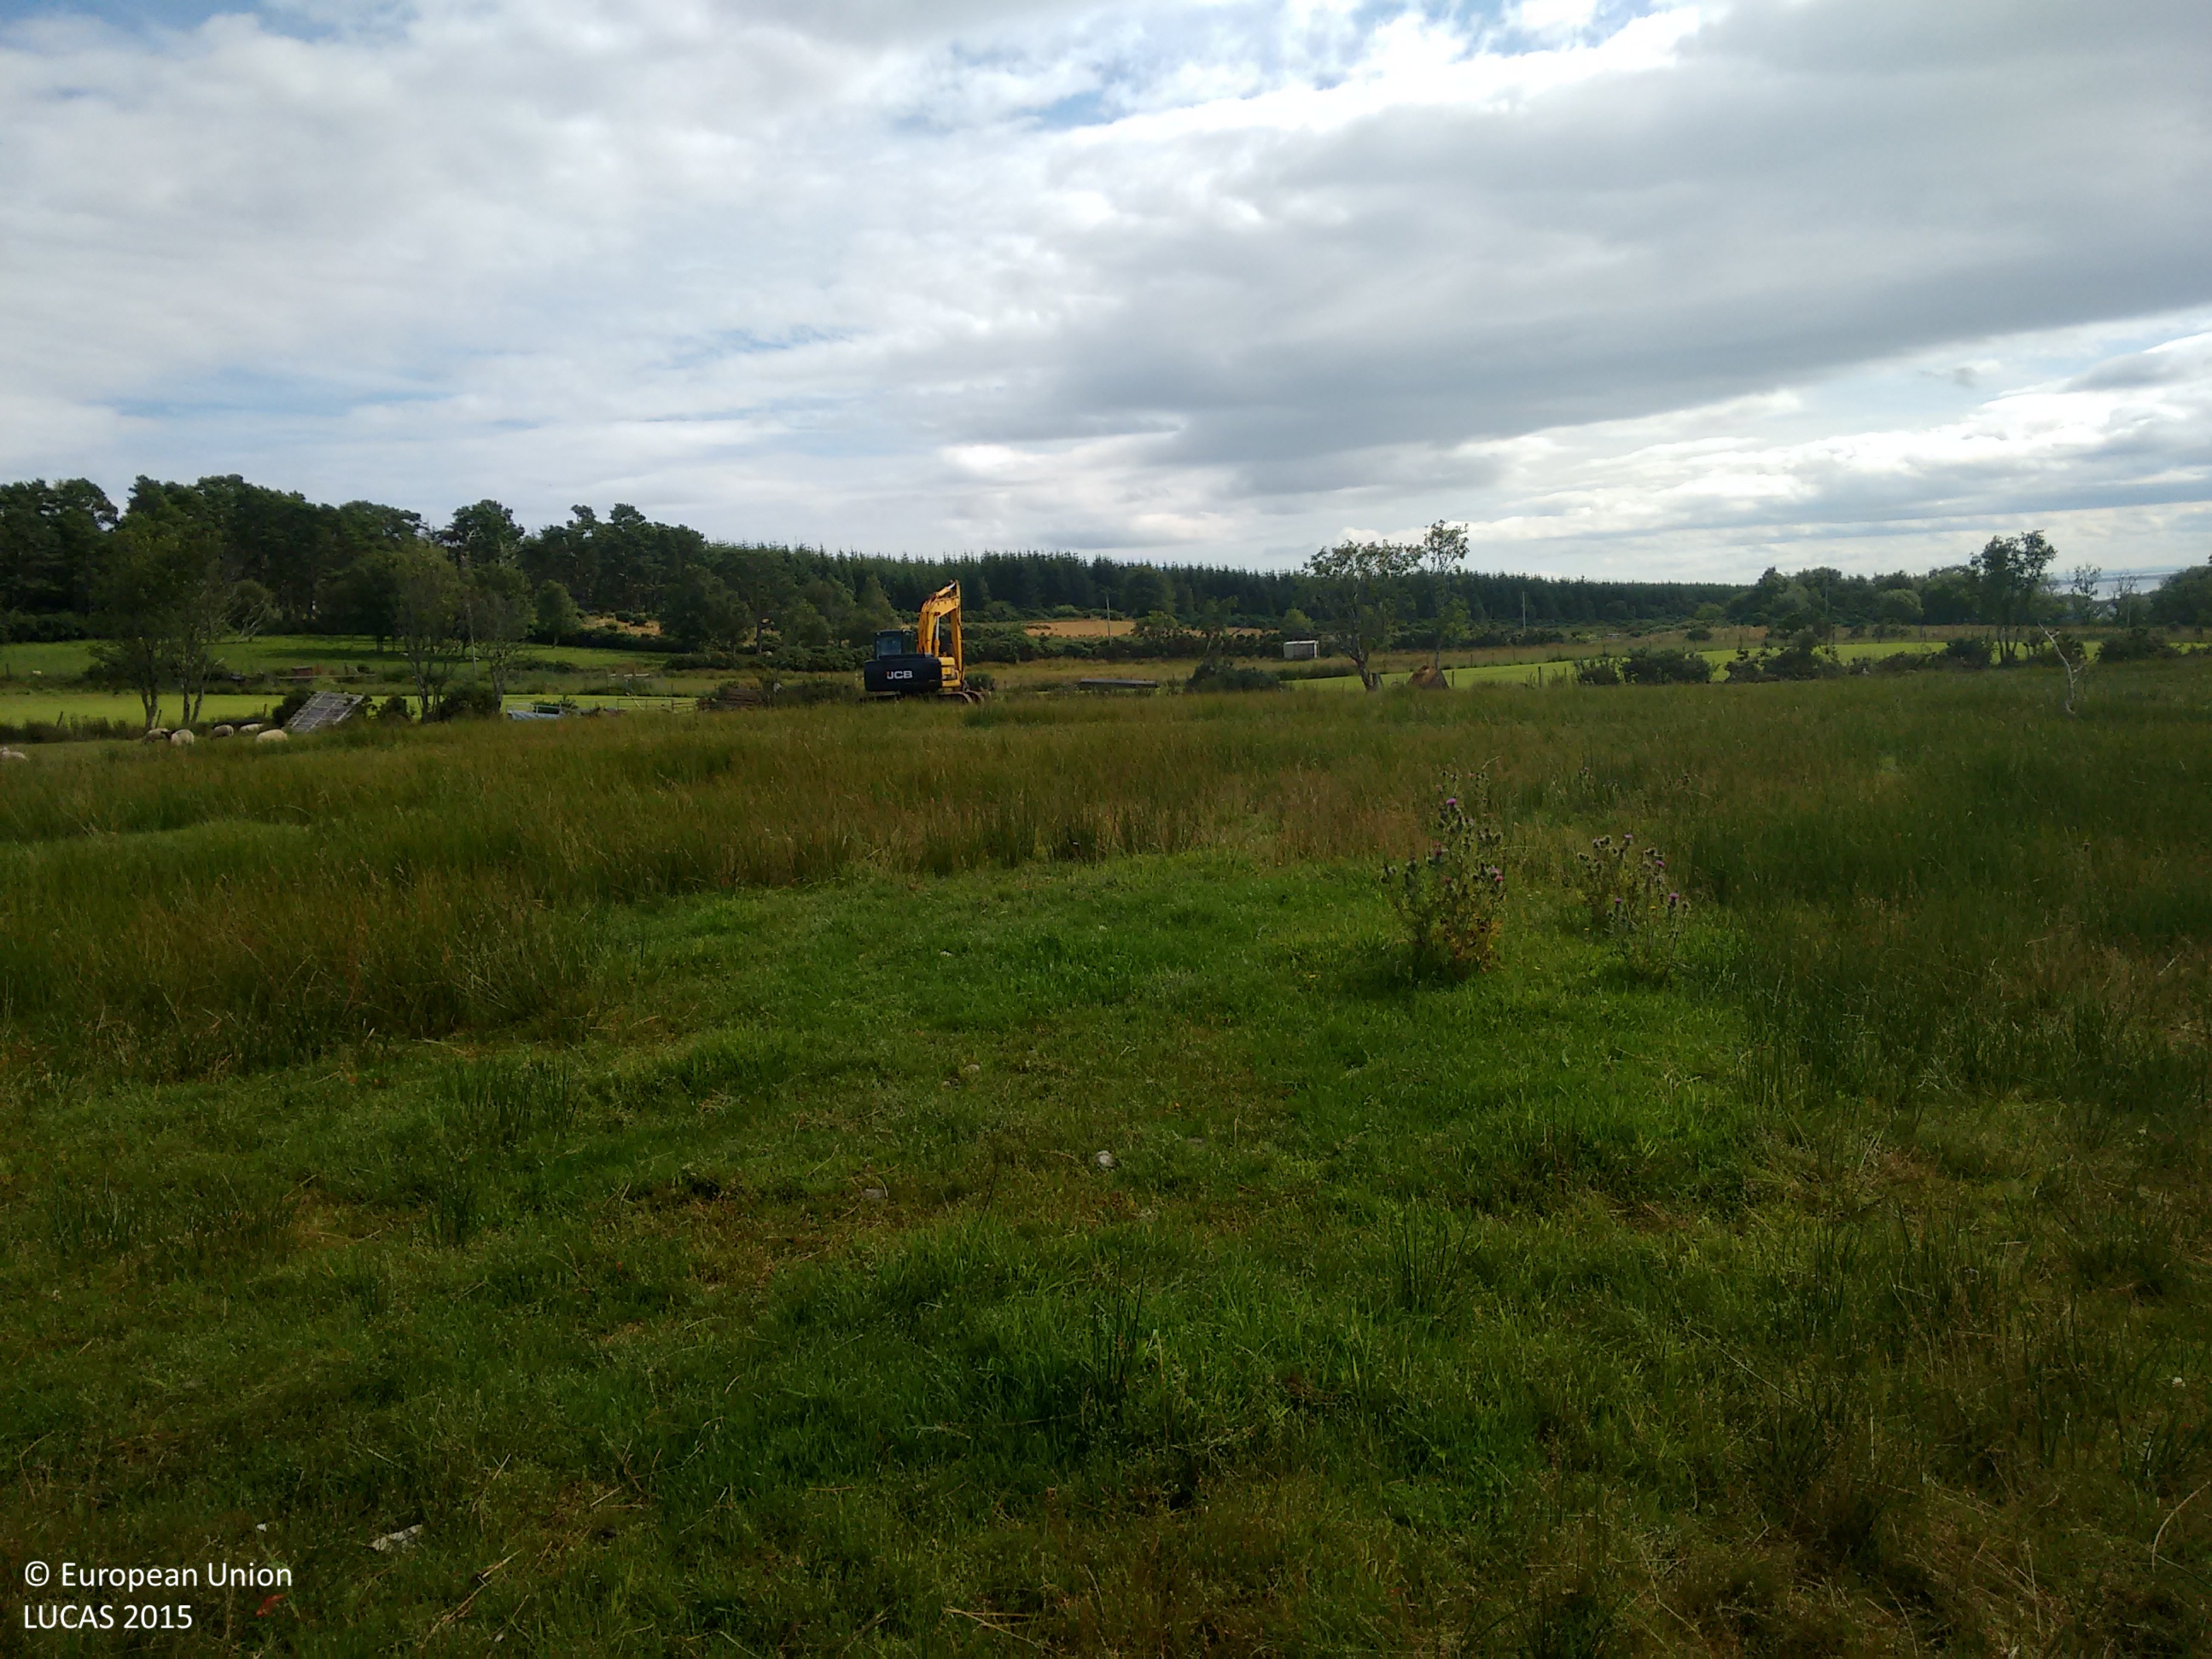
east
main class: Grassland
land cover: Grassland without tree/shrub cover
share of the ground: > 75 %
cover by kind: herbaceous plants 100 %
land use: Agriculture (excluding fallow land and kitchen gardens)
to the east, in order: Grassland without tree/shrub cover; Abandoned hedges; Fences; Grassland without tree/shrub cover; Fences; Grassland without tree/shrub cover; Fences; Abandoned hedges; Tracks; Shrubland with sparse tree cover; Electric lines; Shrubland without tree cover
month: August
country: GB
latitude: 57.9097
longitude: -4.1048
